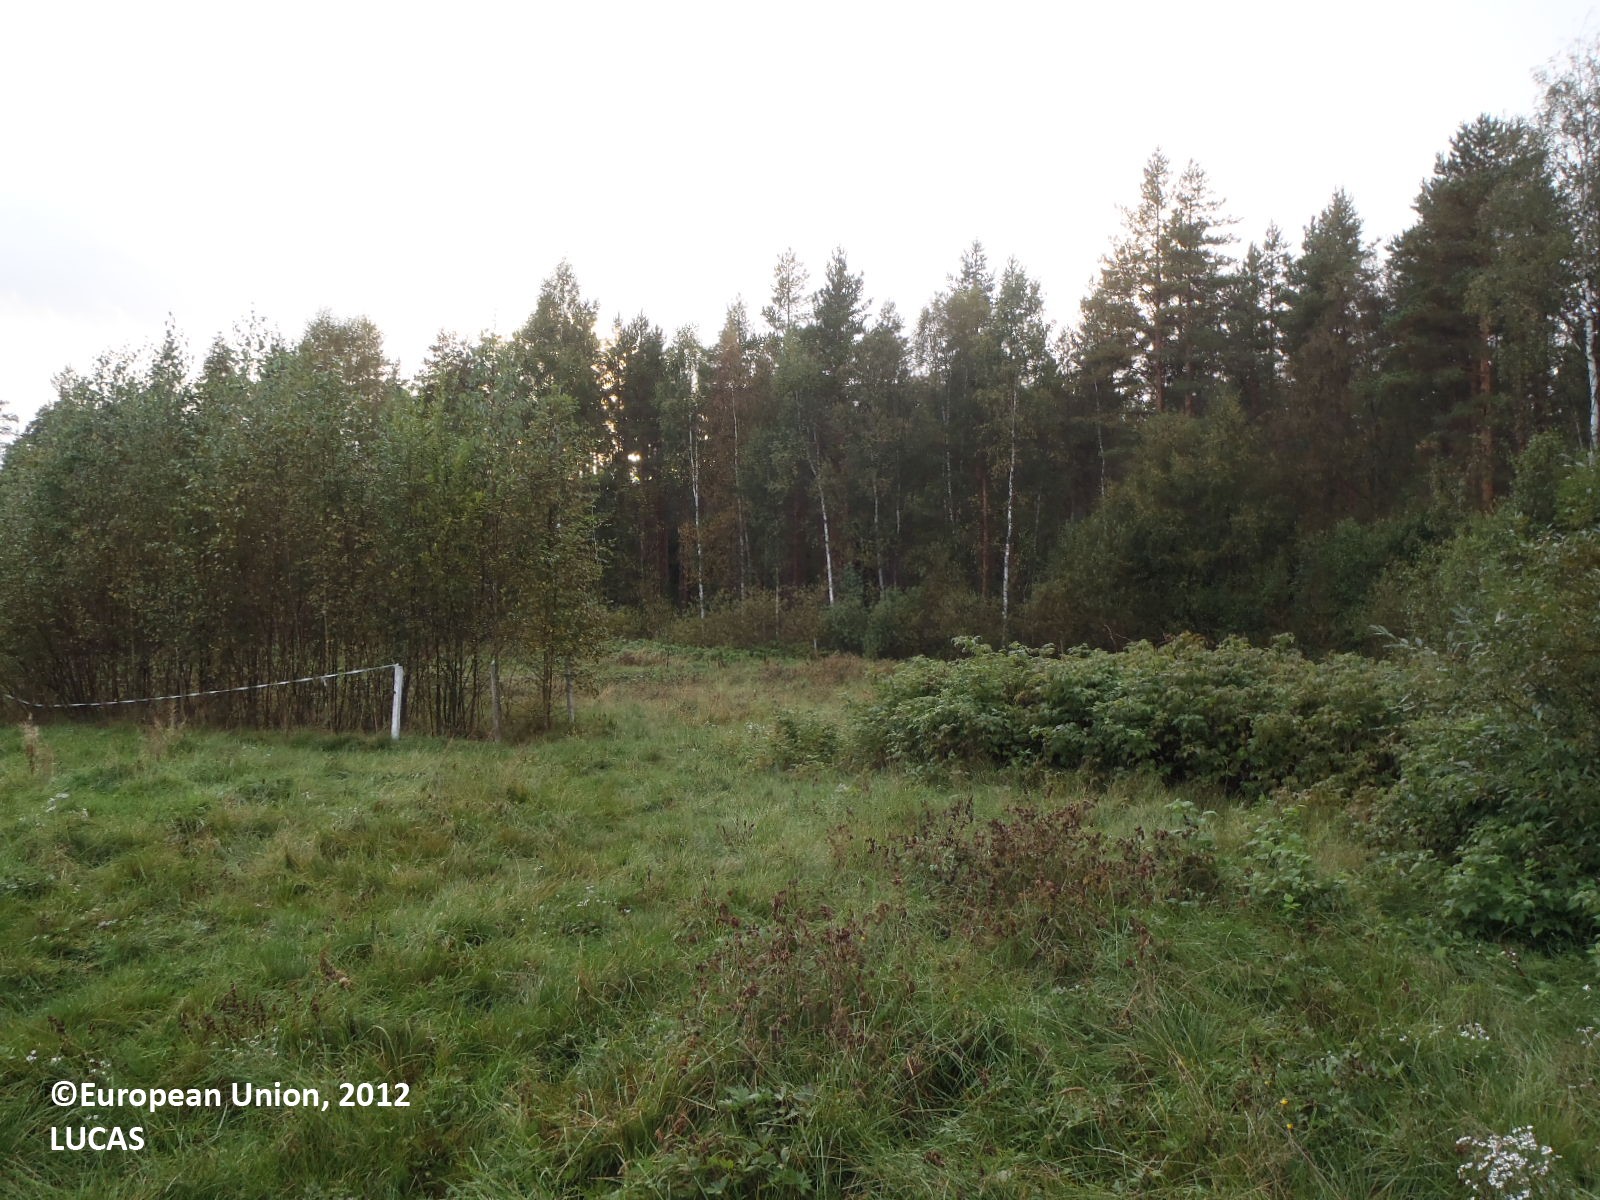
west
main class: Grassland
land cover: Grassland without tree/shrub cover
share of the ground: > 75 %
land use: Agriculture (excluding fallow land and kitchen gardens)
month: September
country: FI
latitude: 61.7061
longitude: 22.4868
